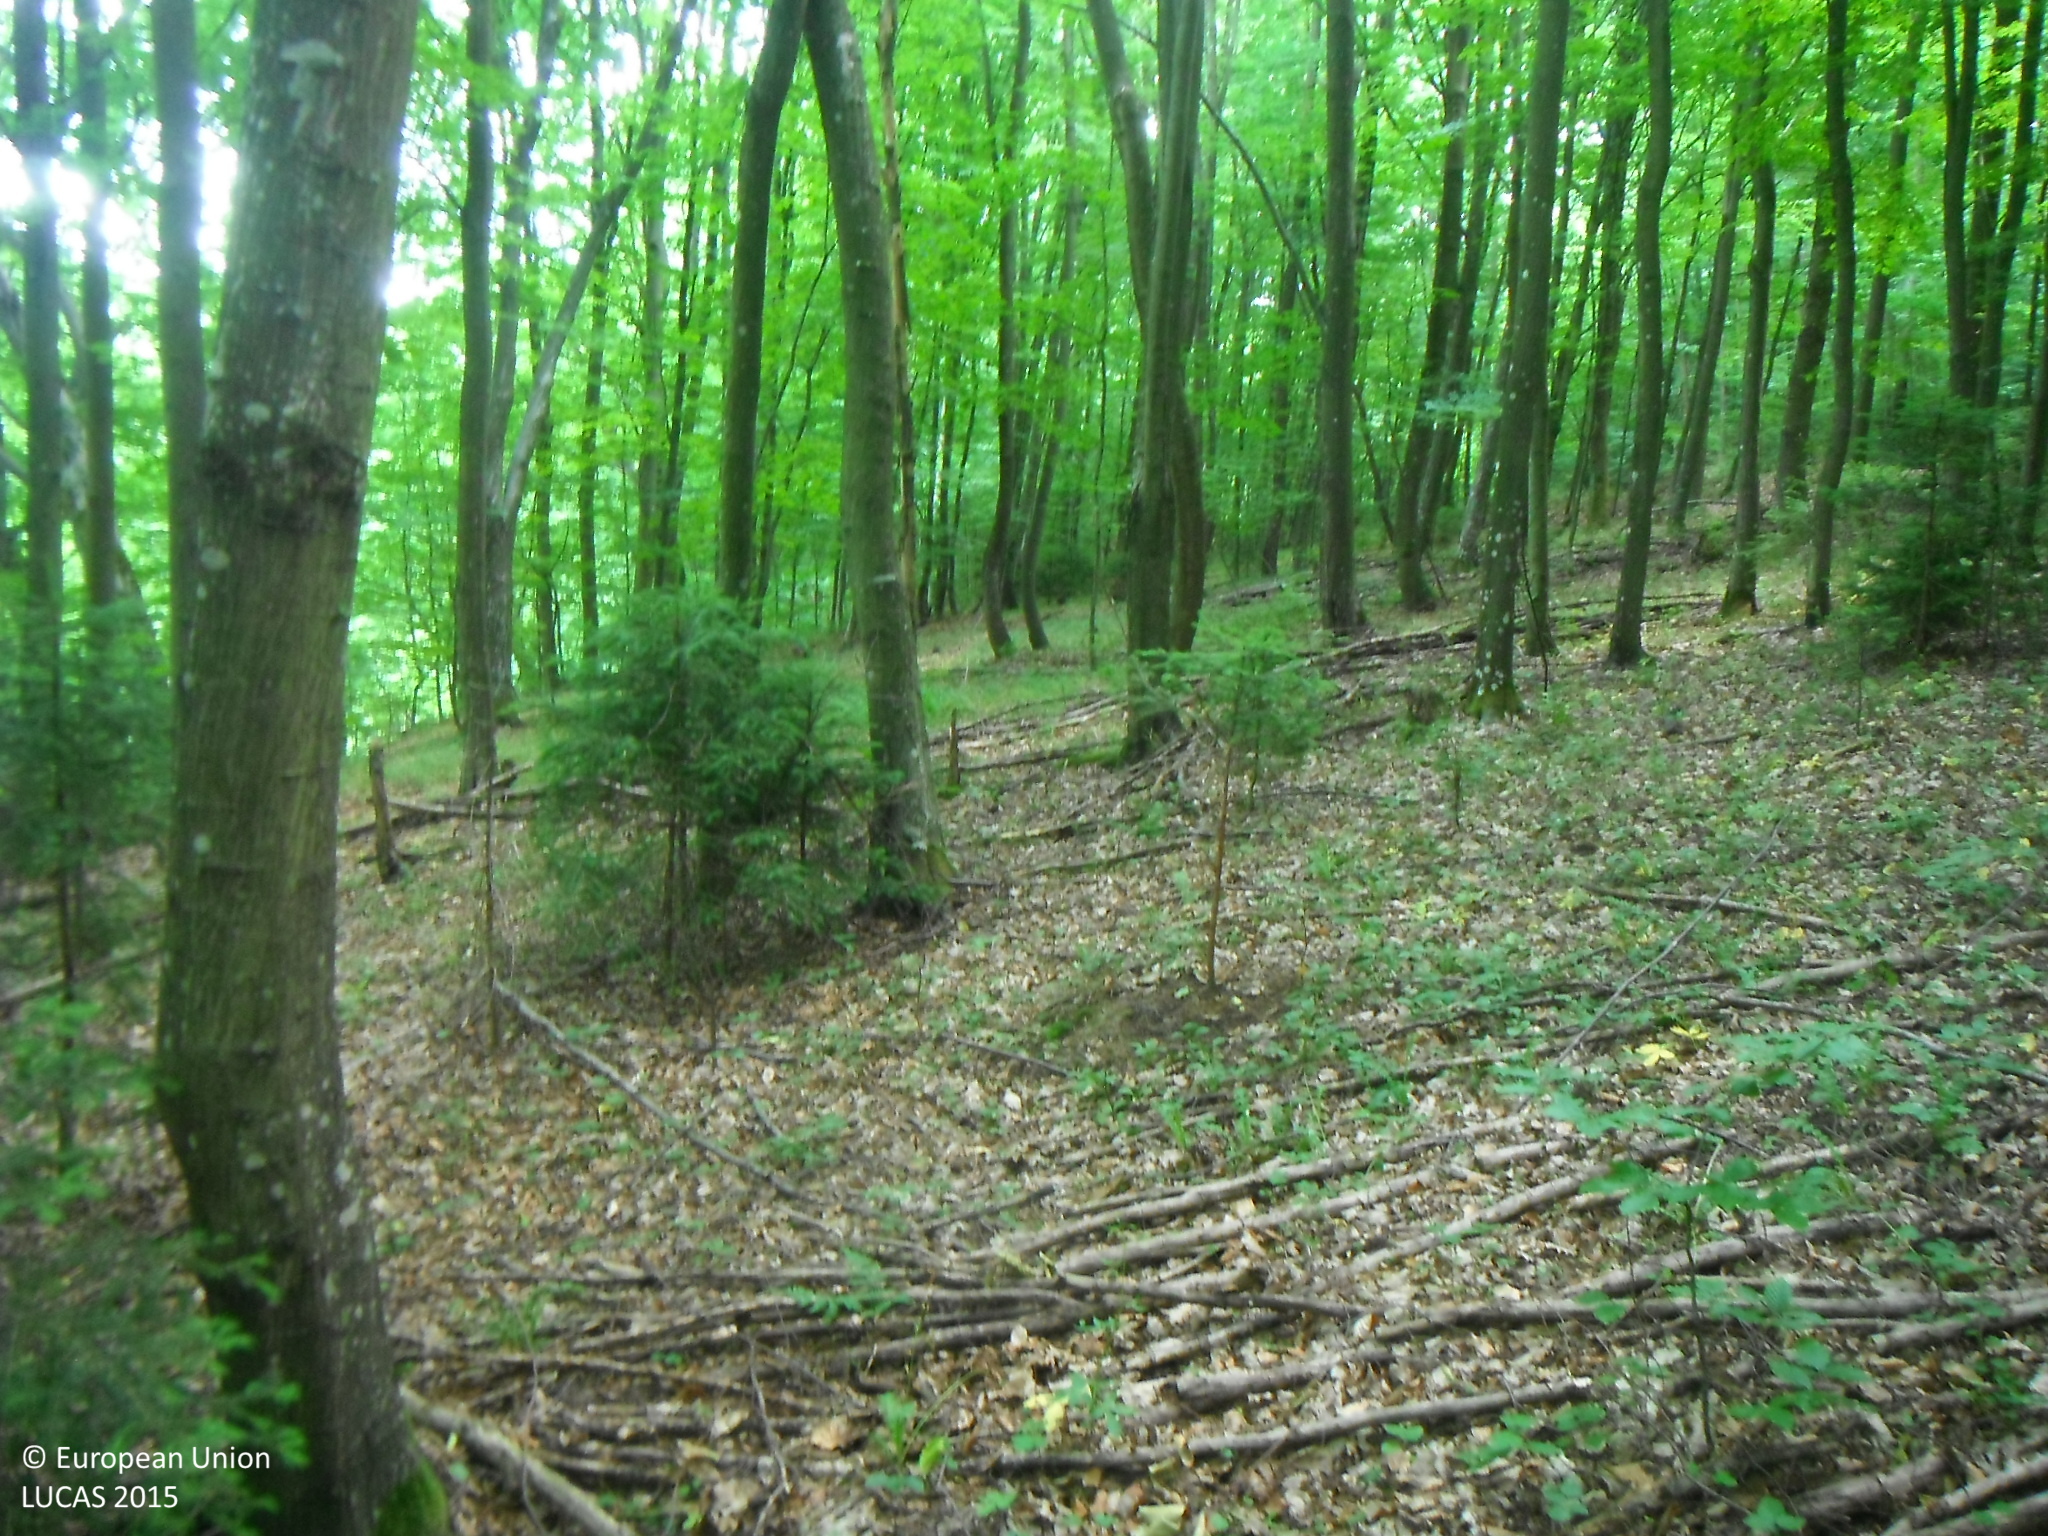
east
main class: Woodland
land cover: Broadleaved woodland
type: beech forest
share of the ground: > 75 %
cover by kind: broadleaved forest trees 100 %
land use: Forestry
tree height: > 5 m
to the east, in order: Broadleaved woodland; Shrubland without tree cover
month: June
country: SK
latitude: 48.9087
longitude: 22.3538
